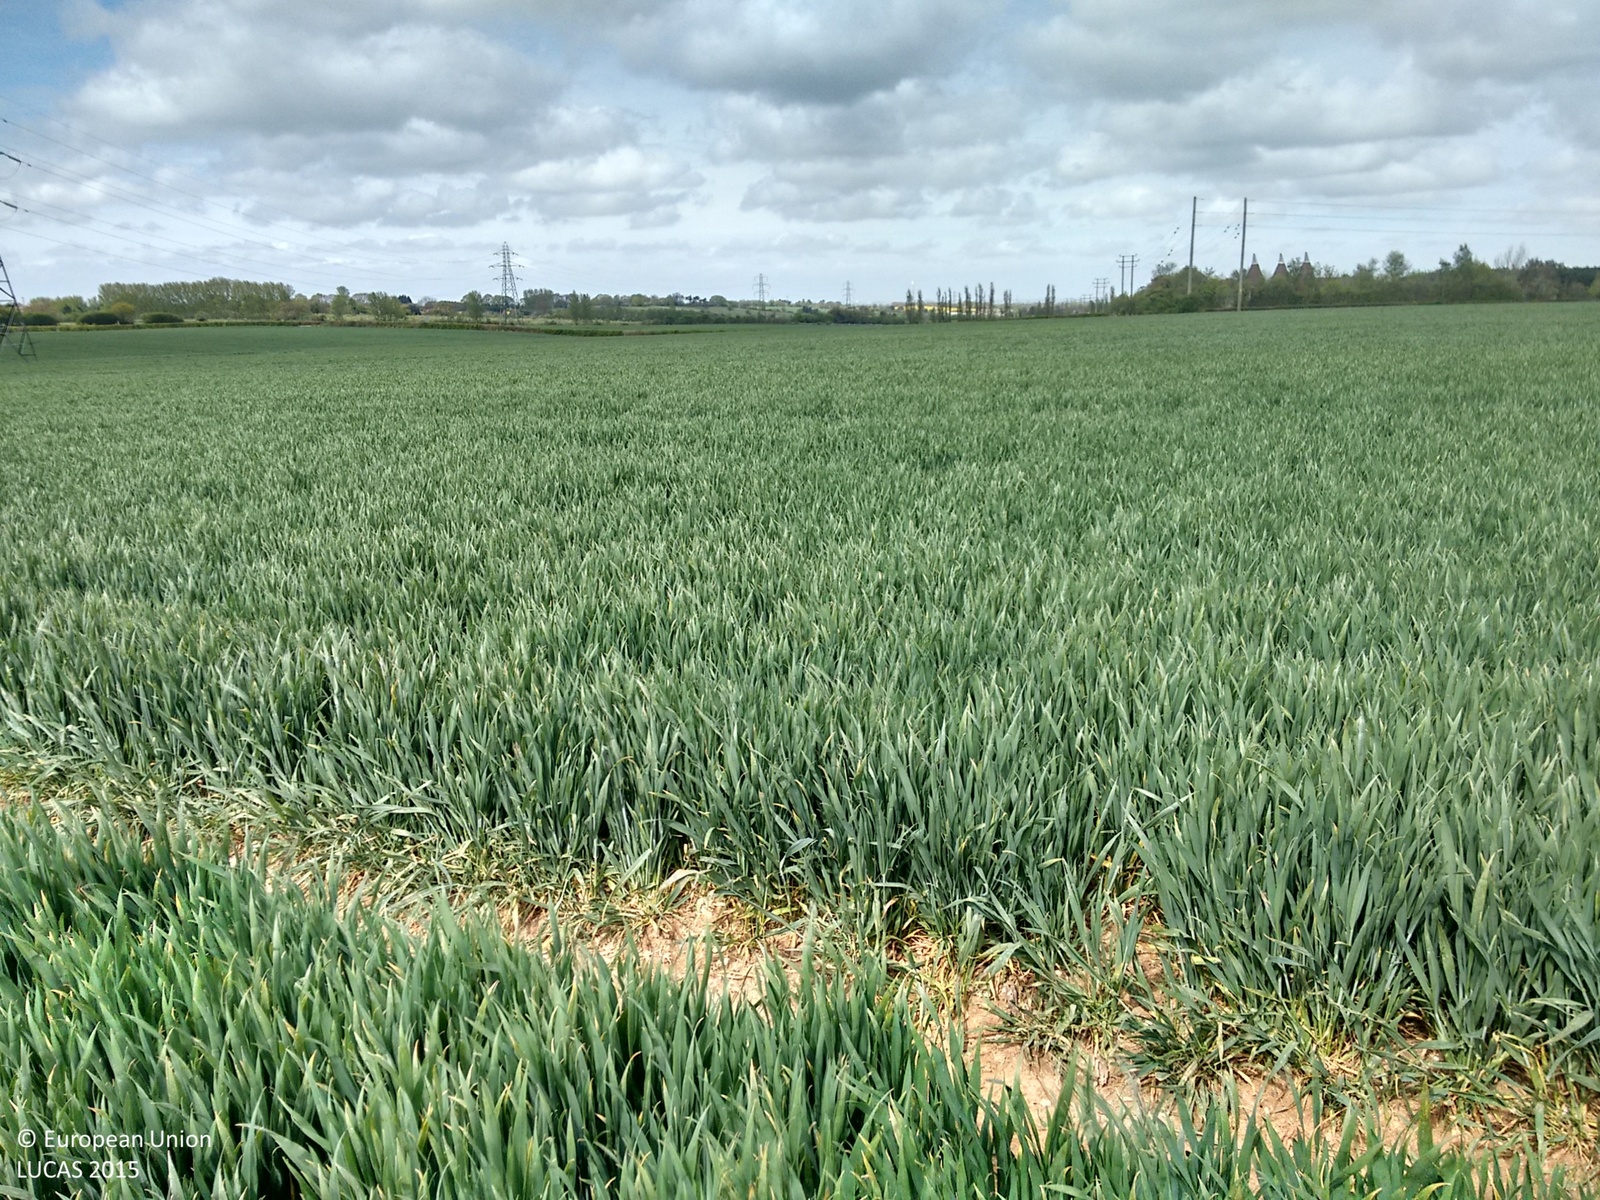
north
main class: Cropland
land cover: Common wheat
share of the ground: > 75 %
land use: Agriculture (excluding fallow land and kitchen gardens)
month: May
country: GB
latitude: 51.3231
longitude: 0.6895
